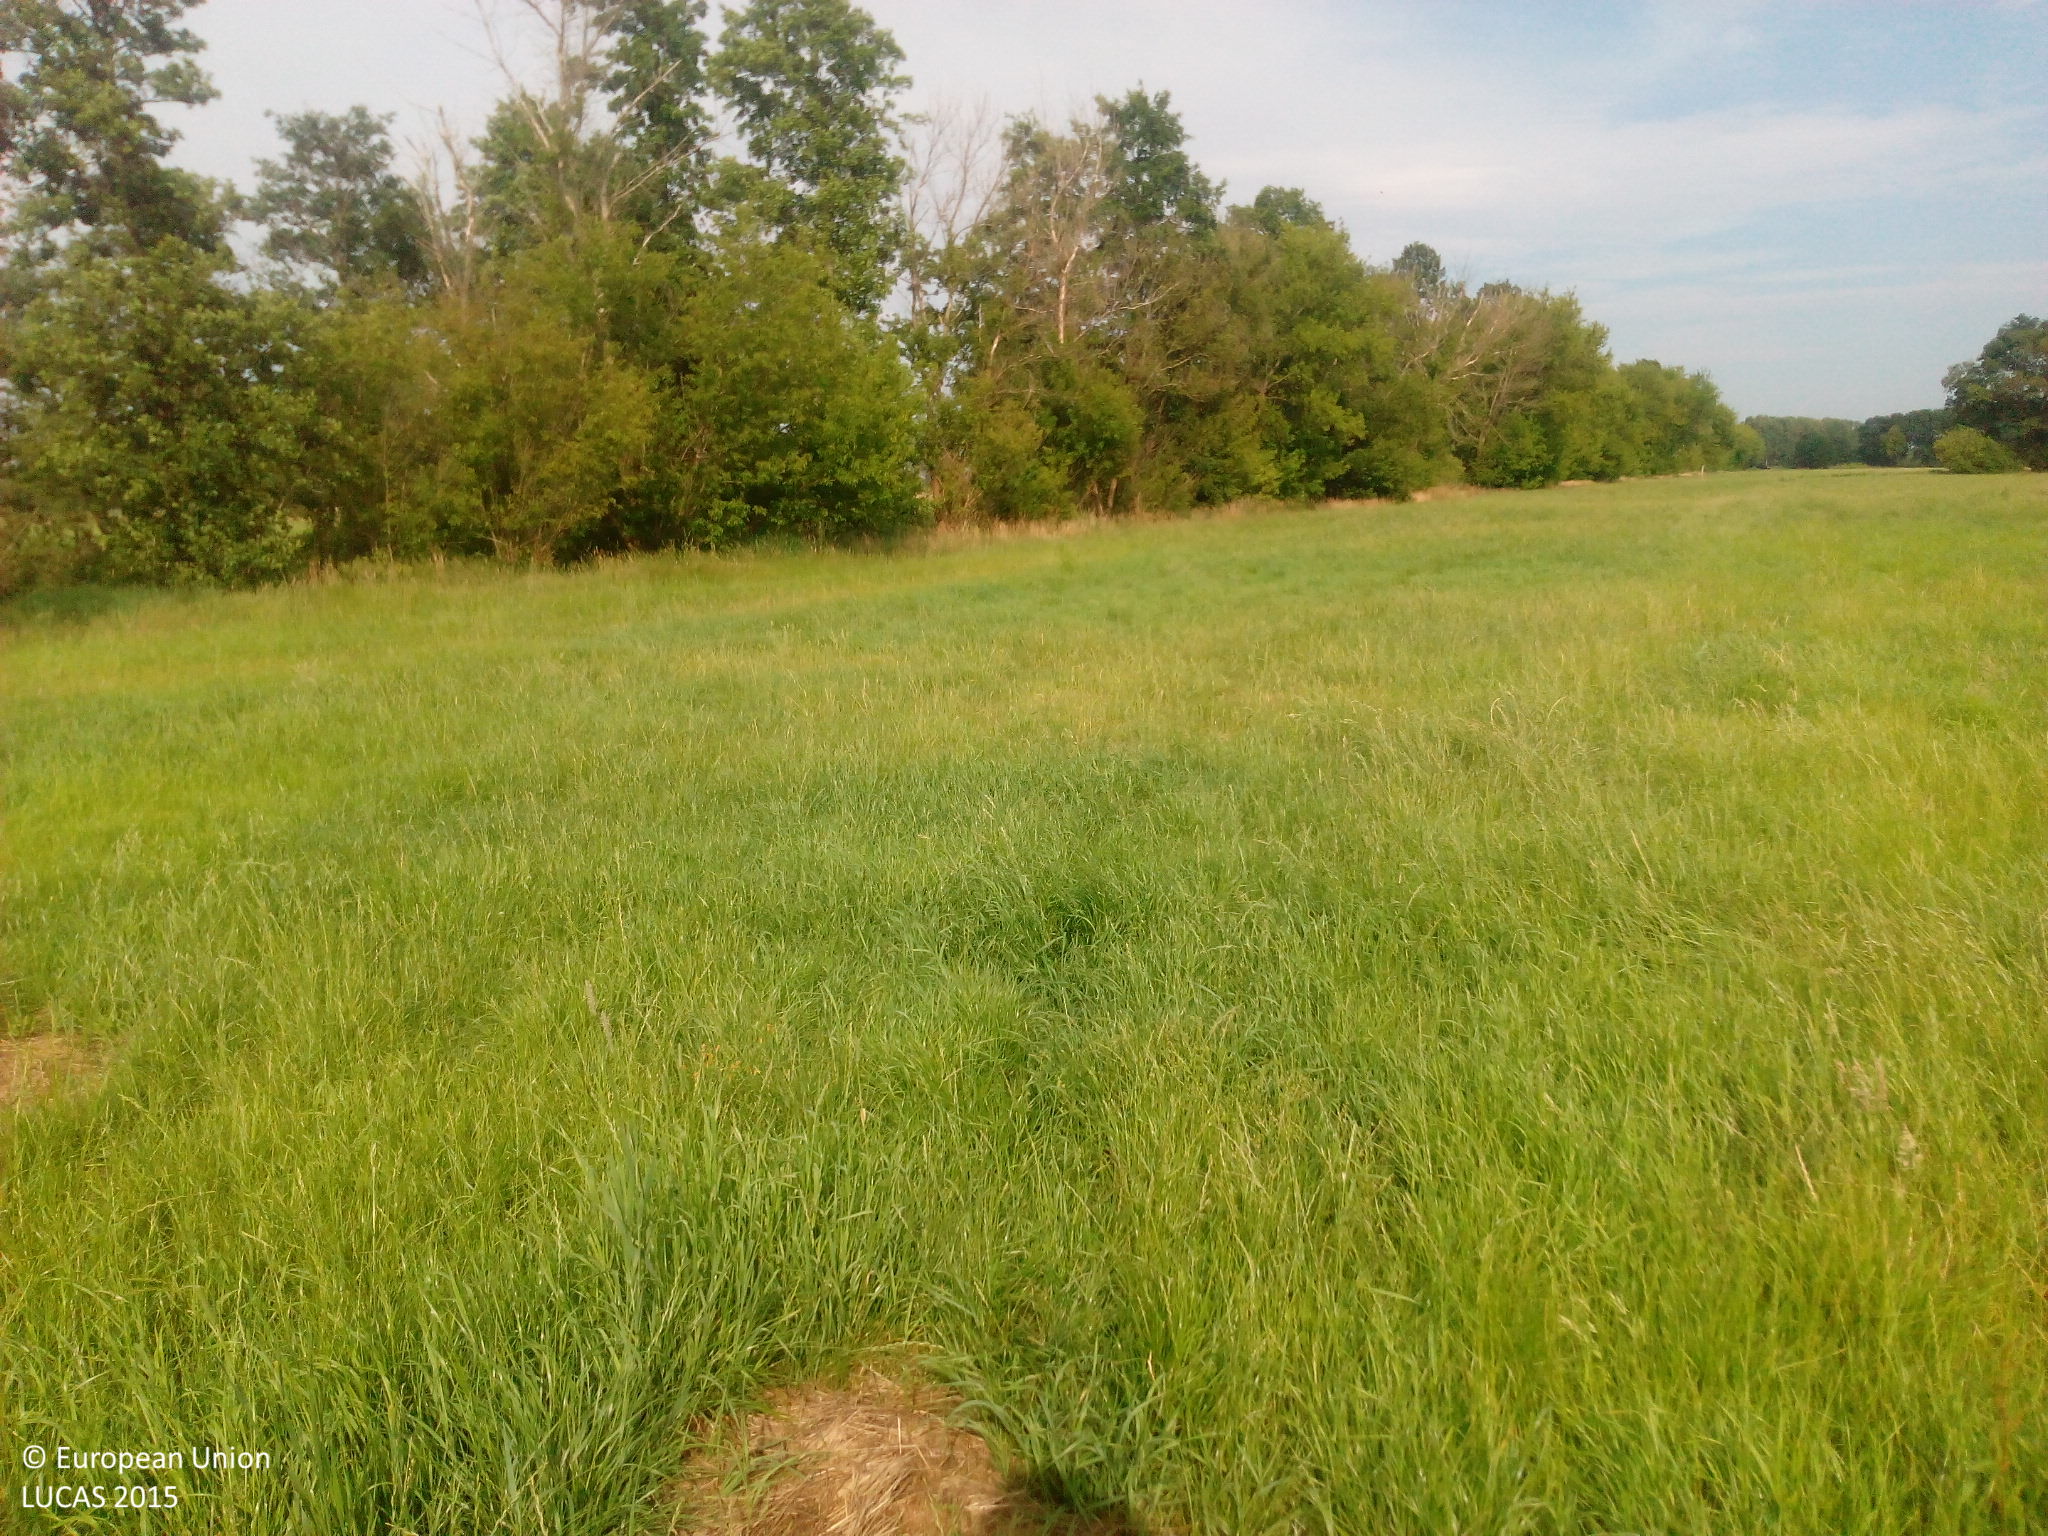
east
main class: Grassland
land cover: Grassland without tree/shrub cover
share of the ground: > 75 %
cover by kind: herbaceous plants 100 %
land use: Agriculture (excluding fallow land and kitchen gardens)
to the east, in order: Grassland without tree/shrub cover; Fences; Broadleaved woodland; Inland fresh running water; Spontaneously vegetated surfaces; Grassland without tree/shrub cover
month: July
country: DE
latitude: 52.7659
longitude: 12.4449
